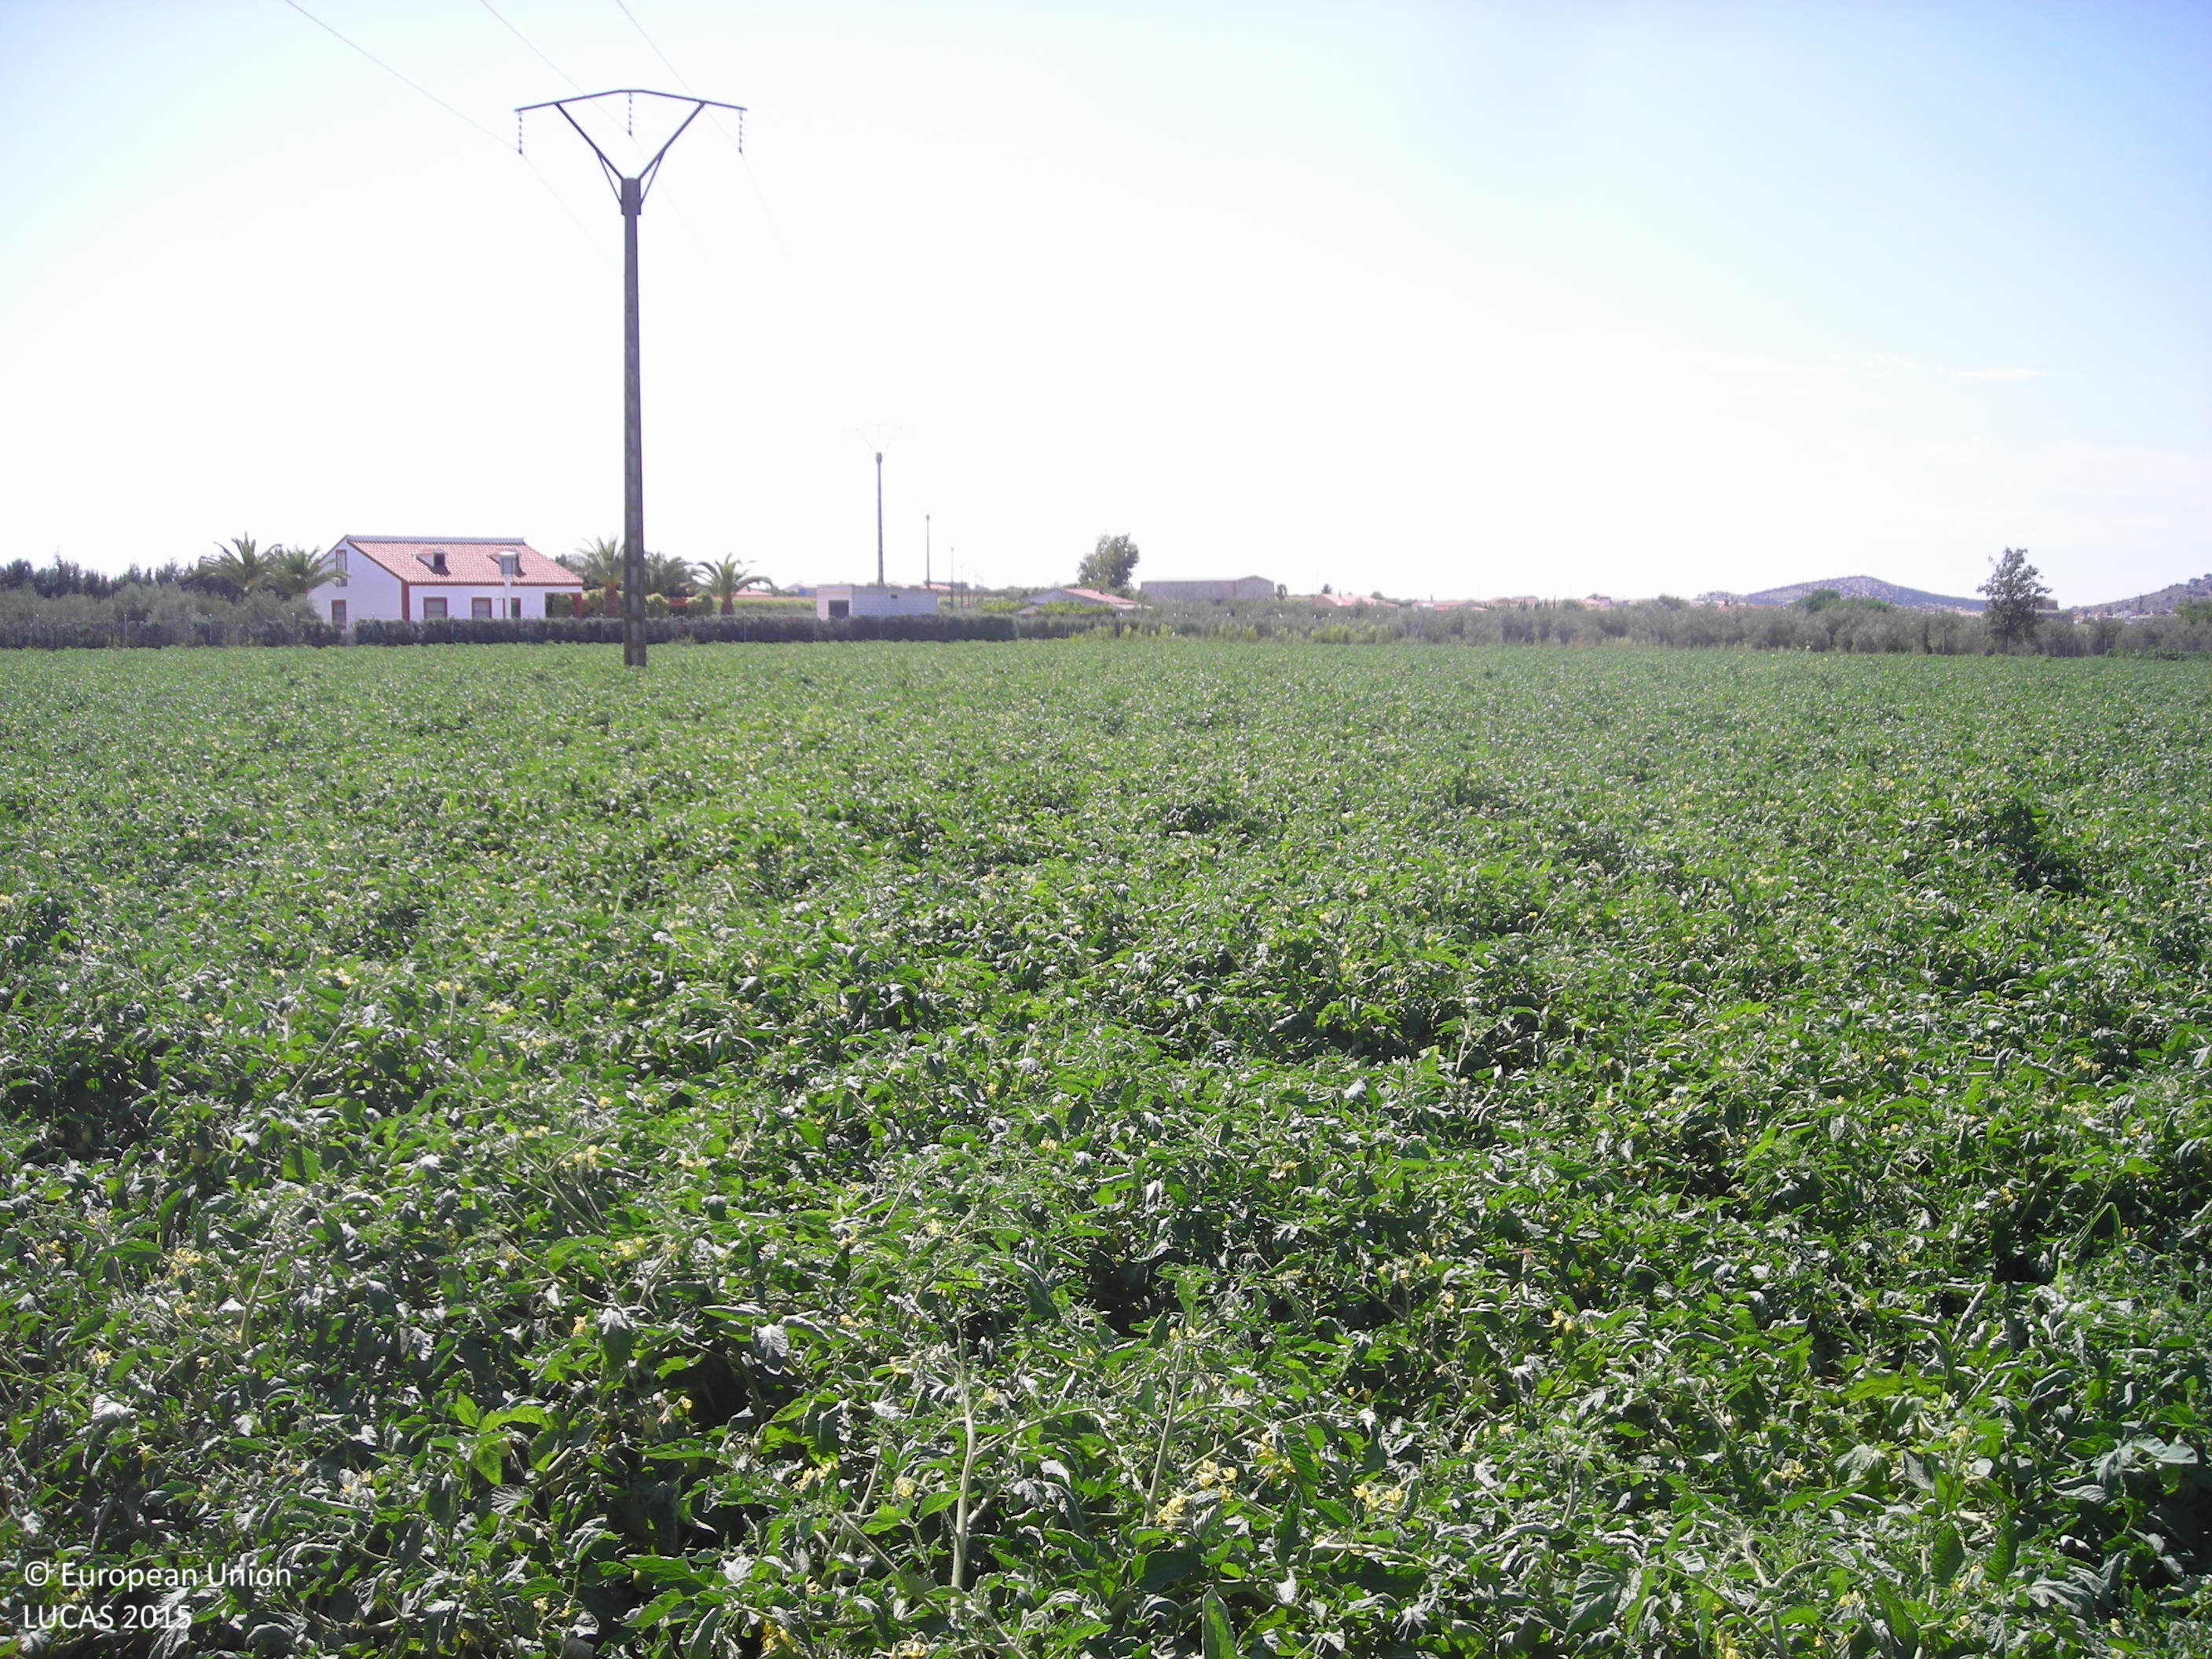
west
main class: Cropland
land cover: Tomatoes
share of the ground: > 75 %
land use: Agriculture (excluding fallow land and kitchen gardens)
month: July
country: ES
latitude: 38.9546
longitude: -5.9404
